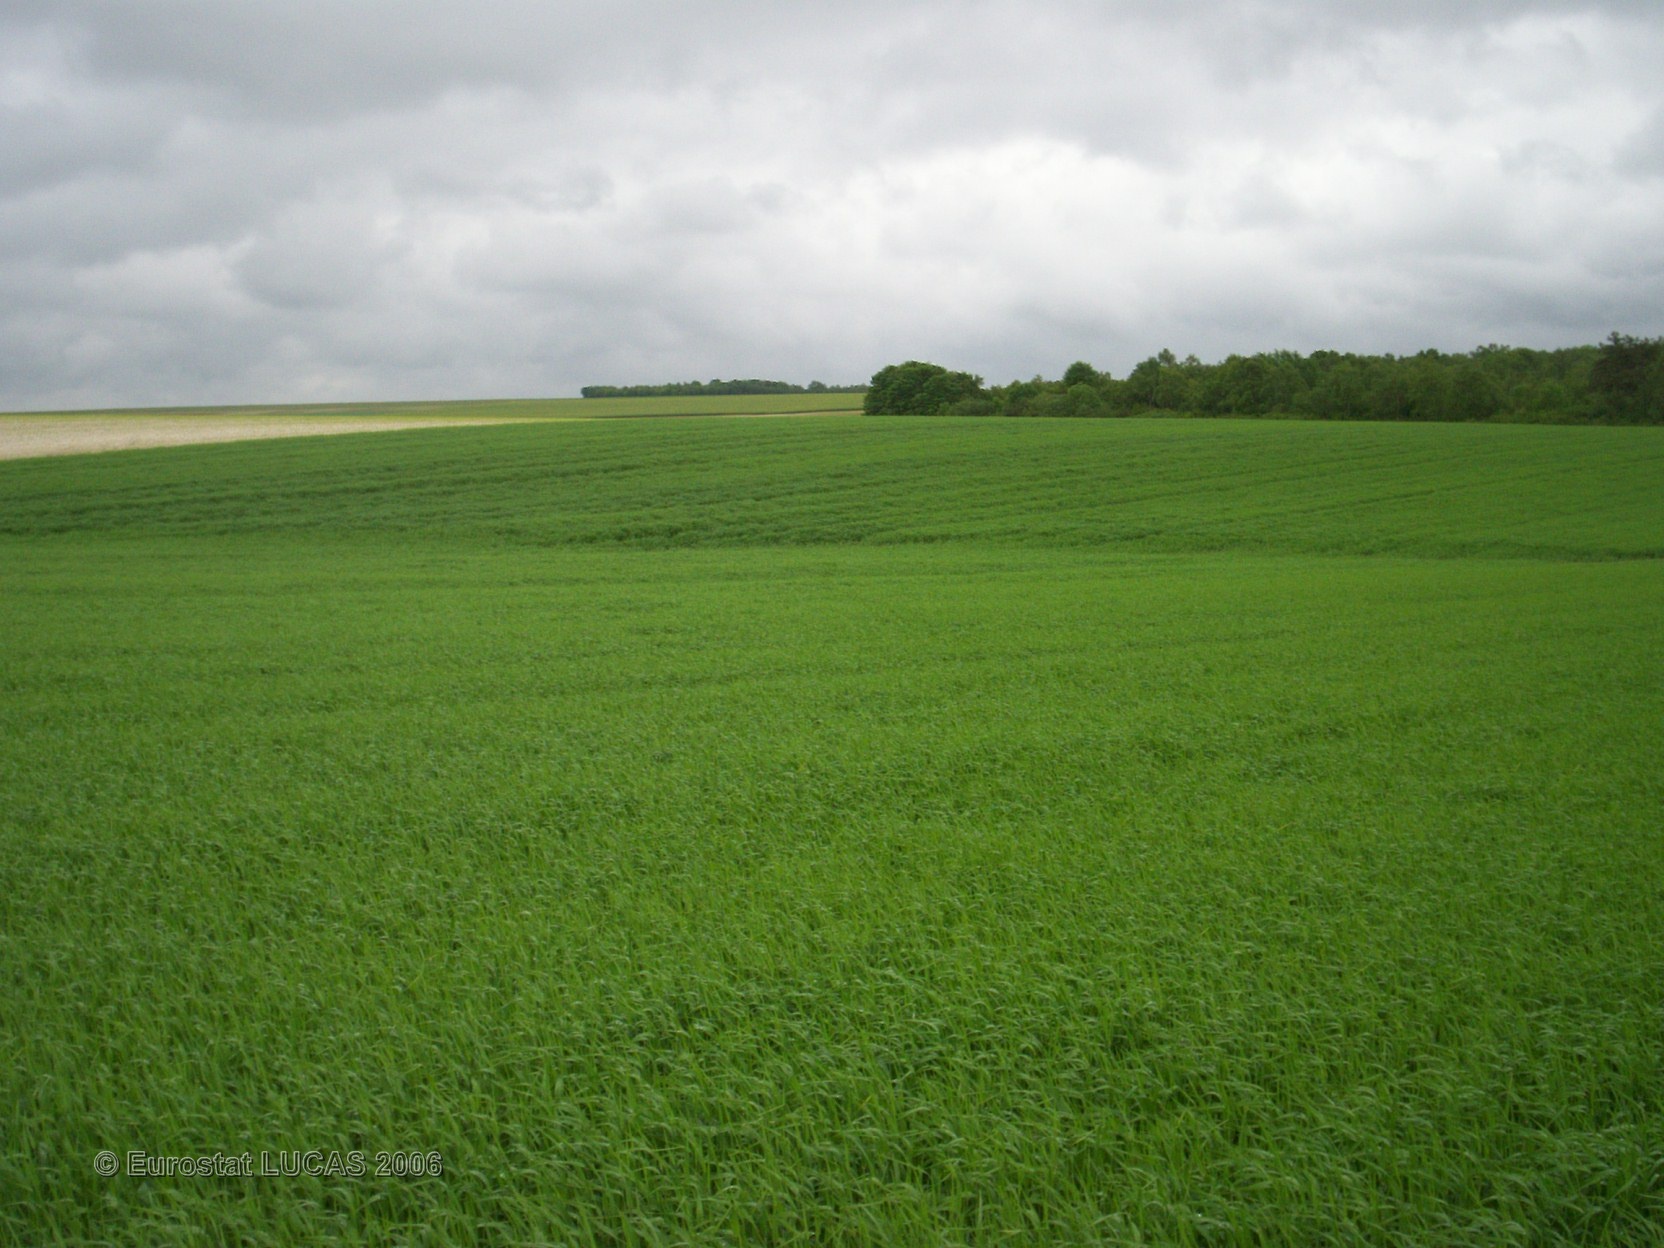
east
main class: Cropland
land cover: Barley
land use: Agriculture (excluding fallow land and kitchen gardens)
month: May
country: FR
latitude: 49.3281
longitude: 4.4511
